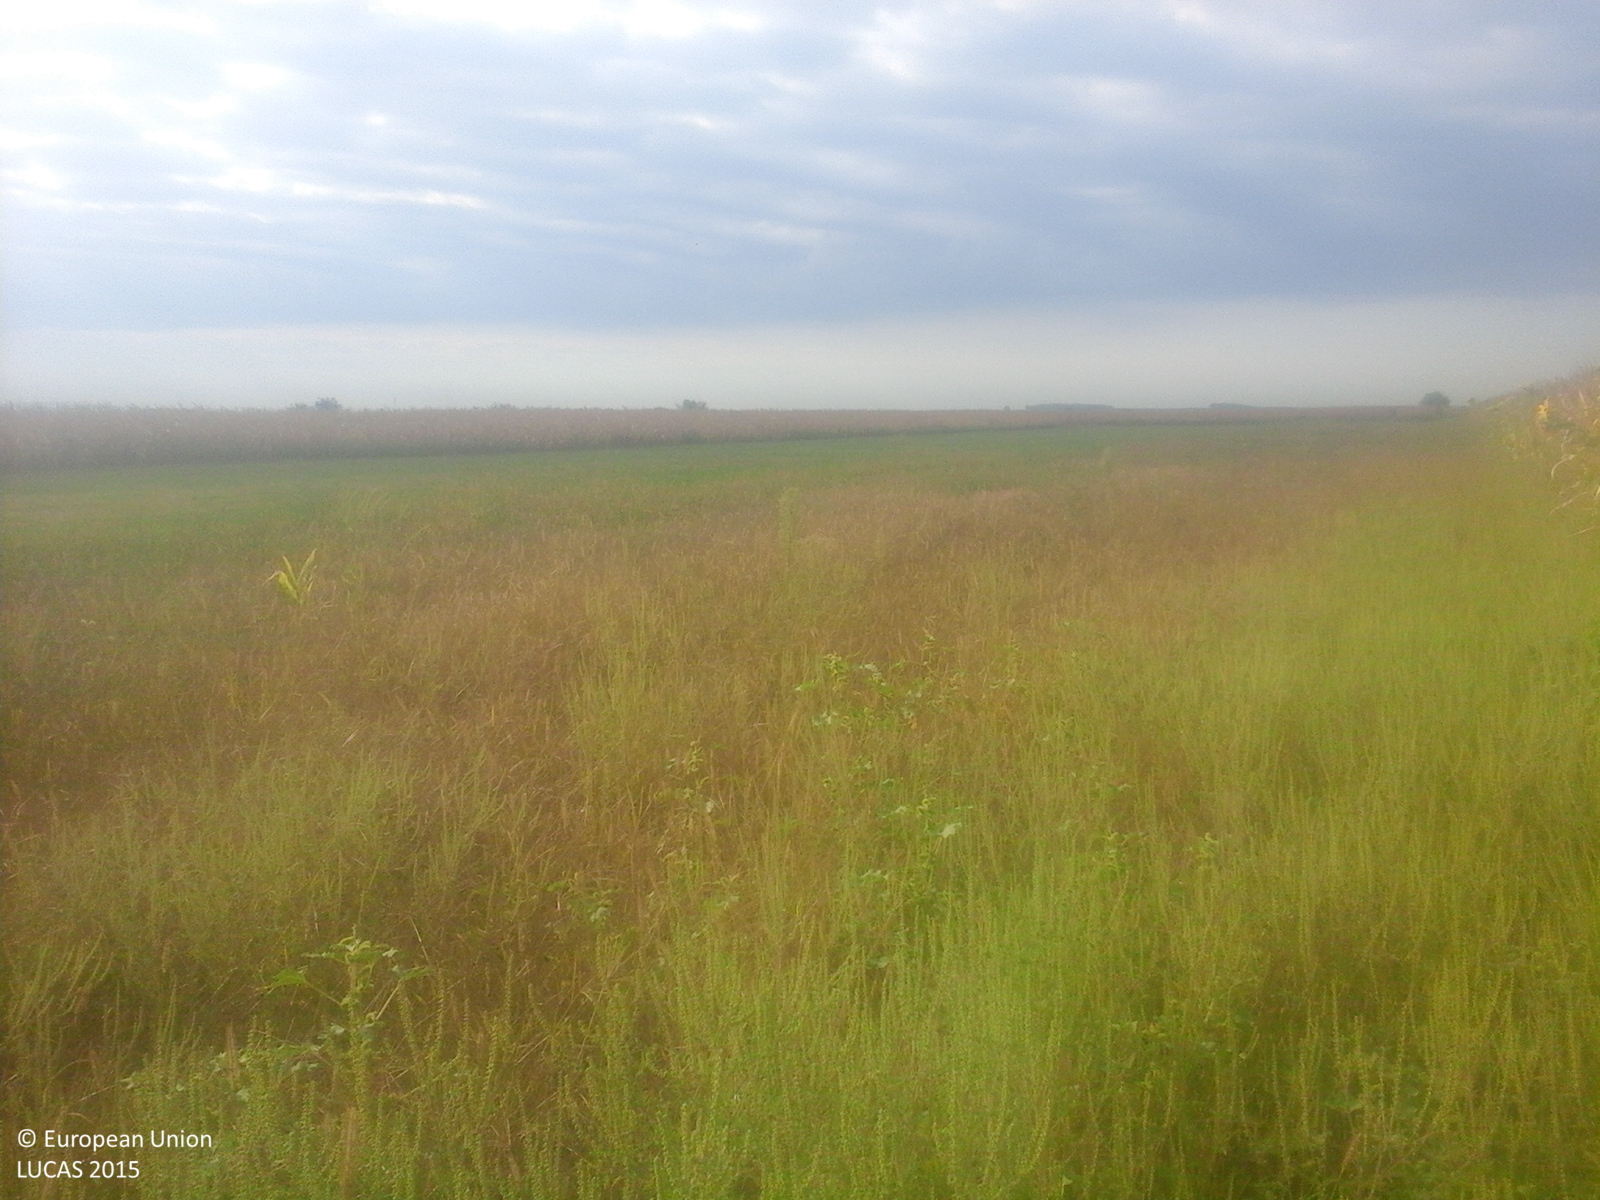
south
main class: Cropland
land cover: Maize
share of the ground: > 75 %
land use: Agriculture (excluding fallow land and kitchen gardens)
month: September
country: RO
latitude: 47.7915
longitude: 22.7304
